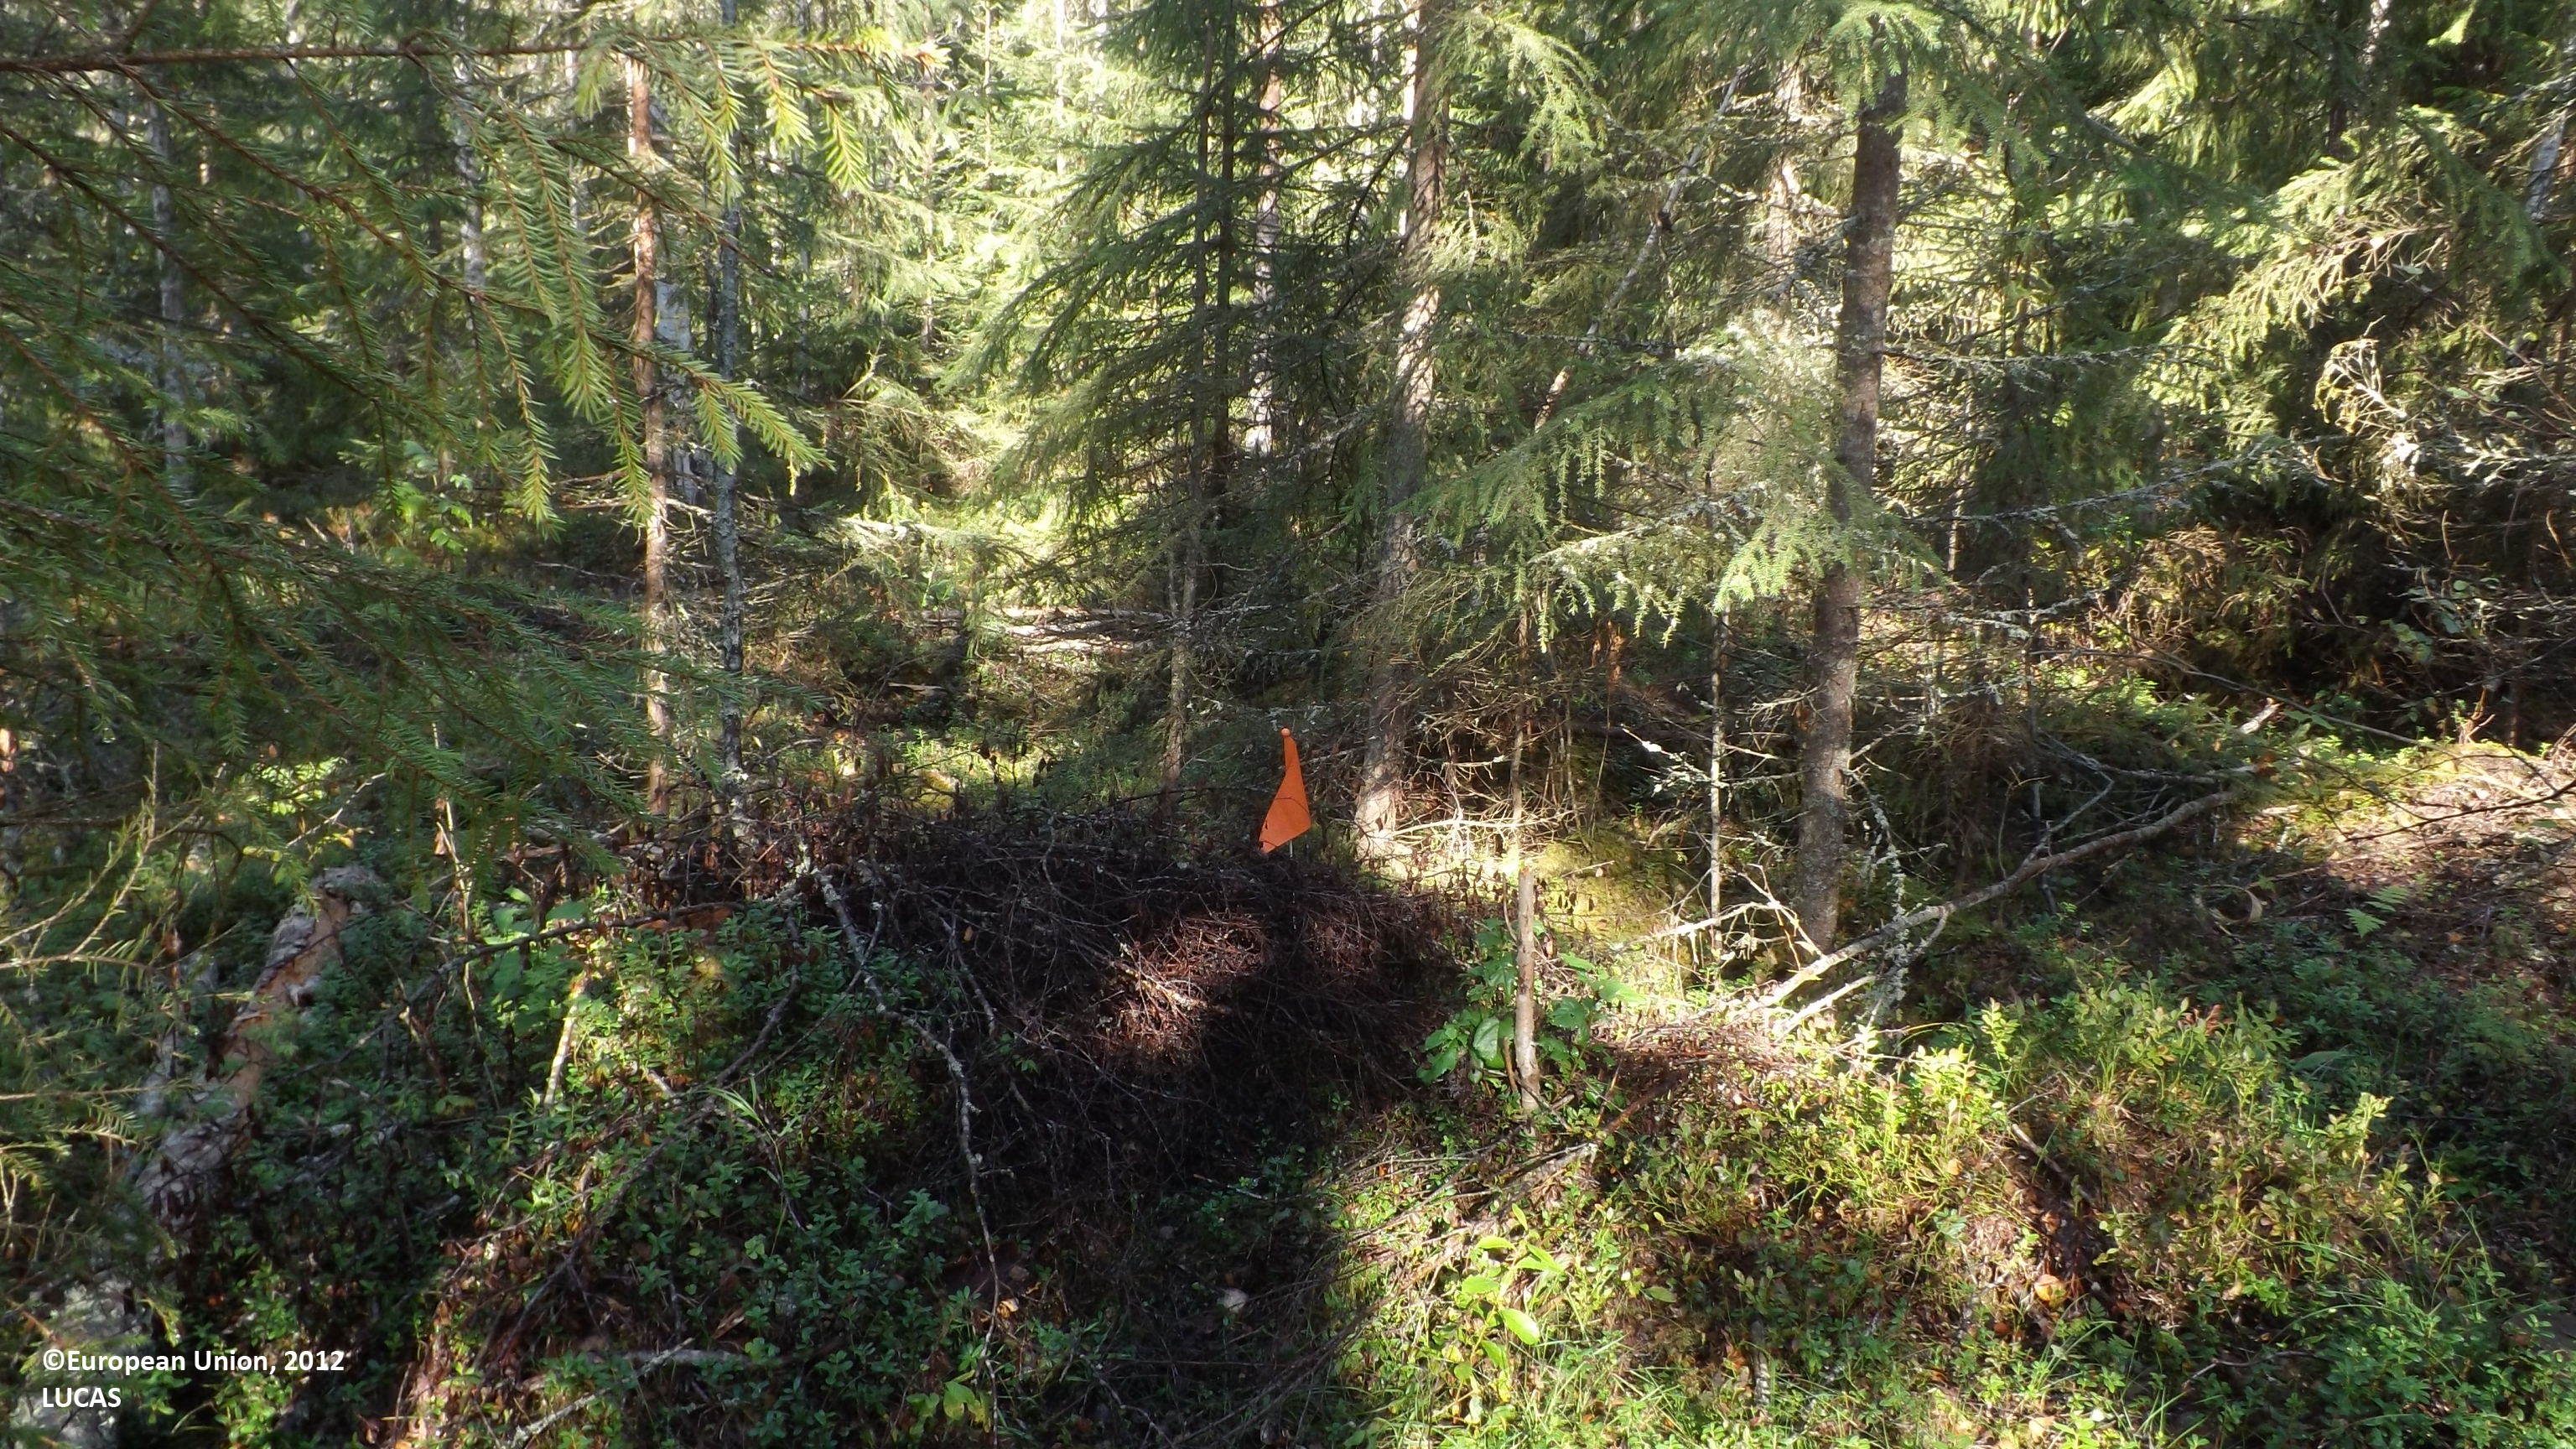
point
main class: Woodland
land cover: Spruce dominated mixed woodland
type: boreal forest
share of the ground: 50 - 75 %
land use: Forestry
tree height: > 5 m
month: August
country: FI
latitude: 63.6467
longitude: 23.7751
